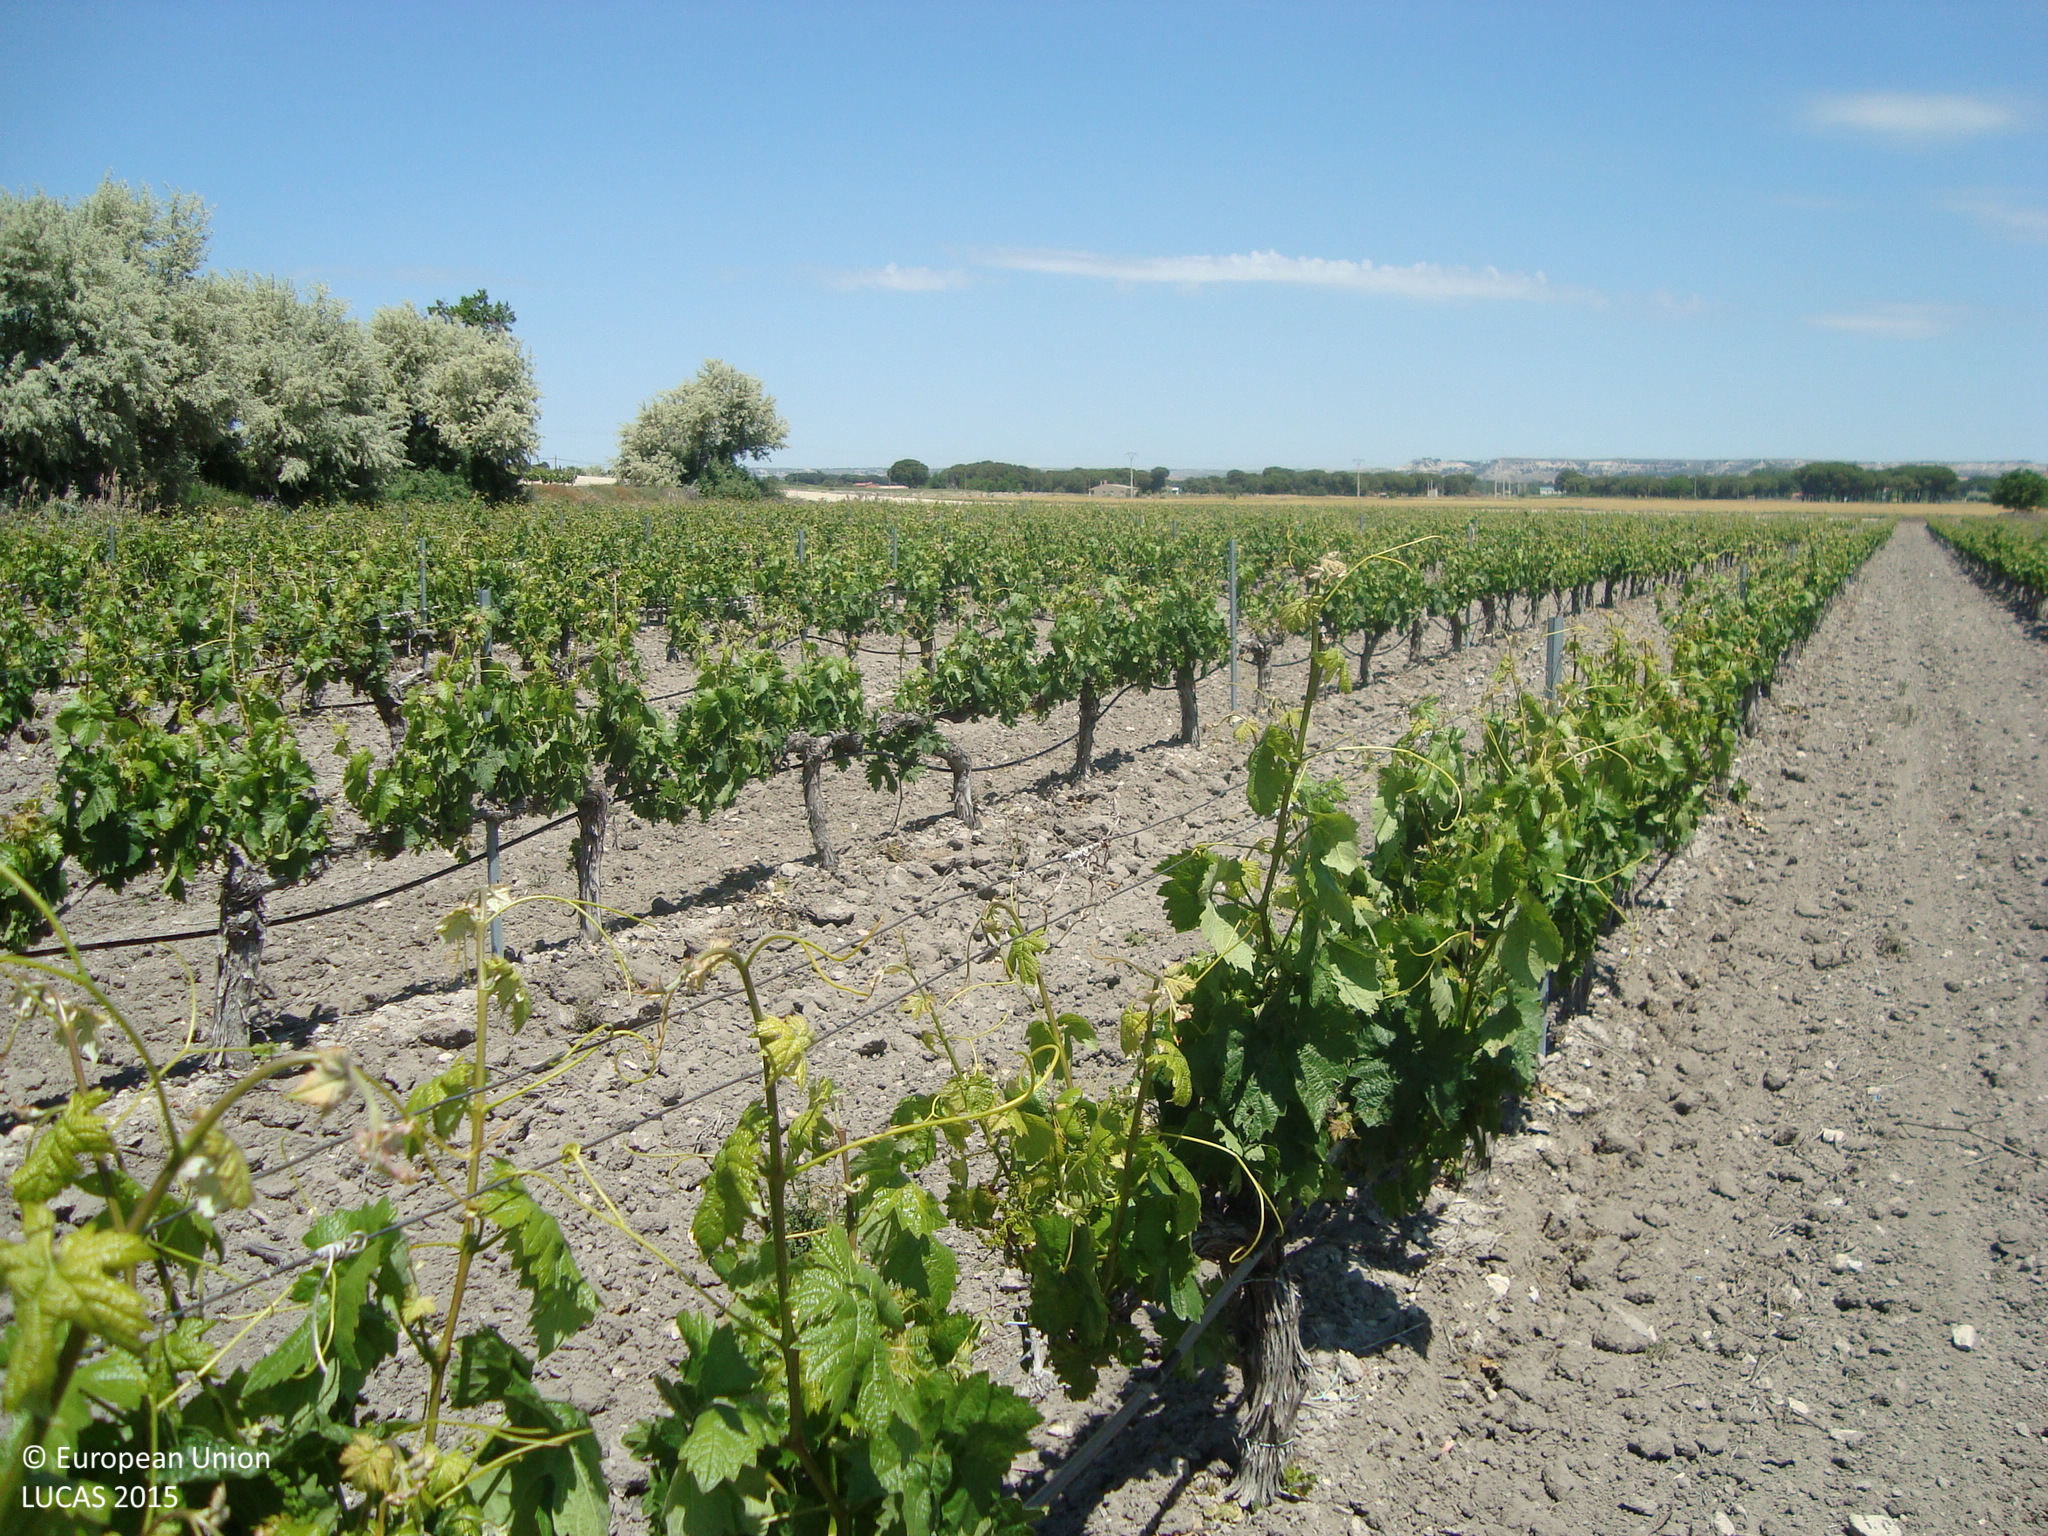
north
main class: Cropland
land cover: Vineyards
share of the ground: 10 - 25 %
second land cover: Other bare soil
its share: > 75 %
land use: Agriculture (excluding fallow land and kitchen gardens)
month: May
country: ES
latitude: 41.5670
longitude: -4.1246
